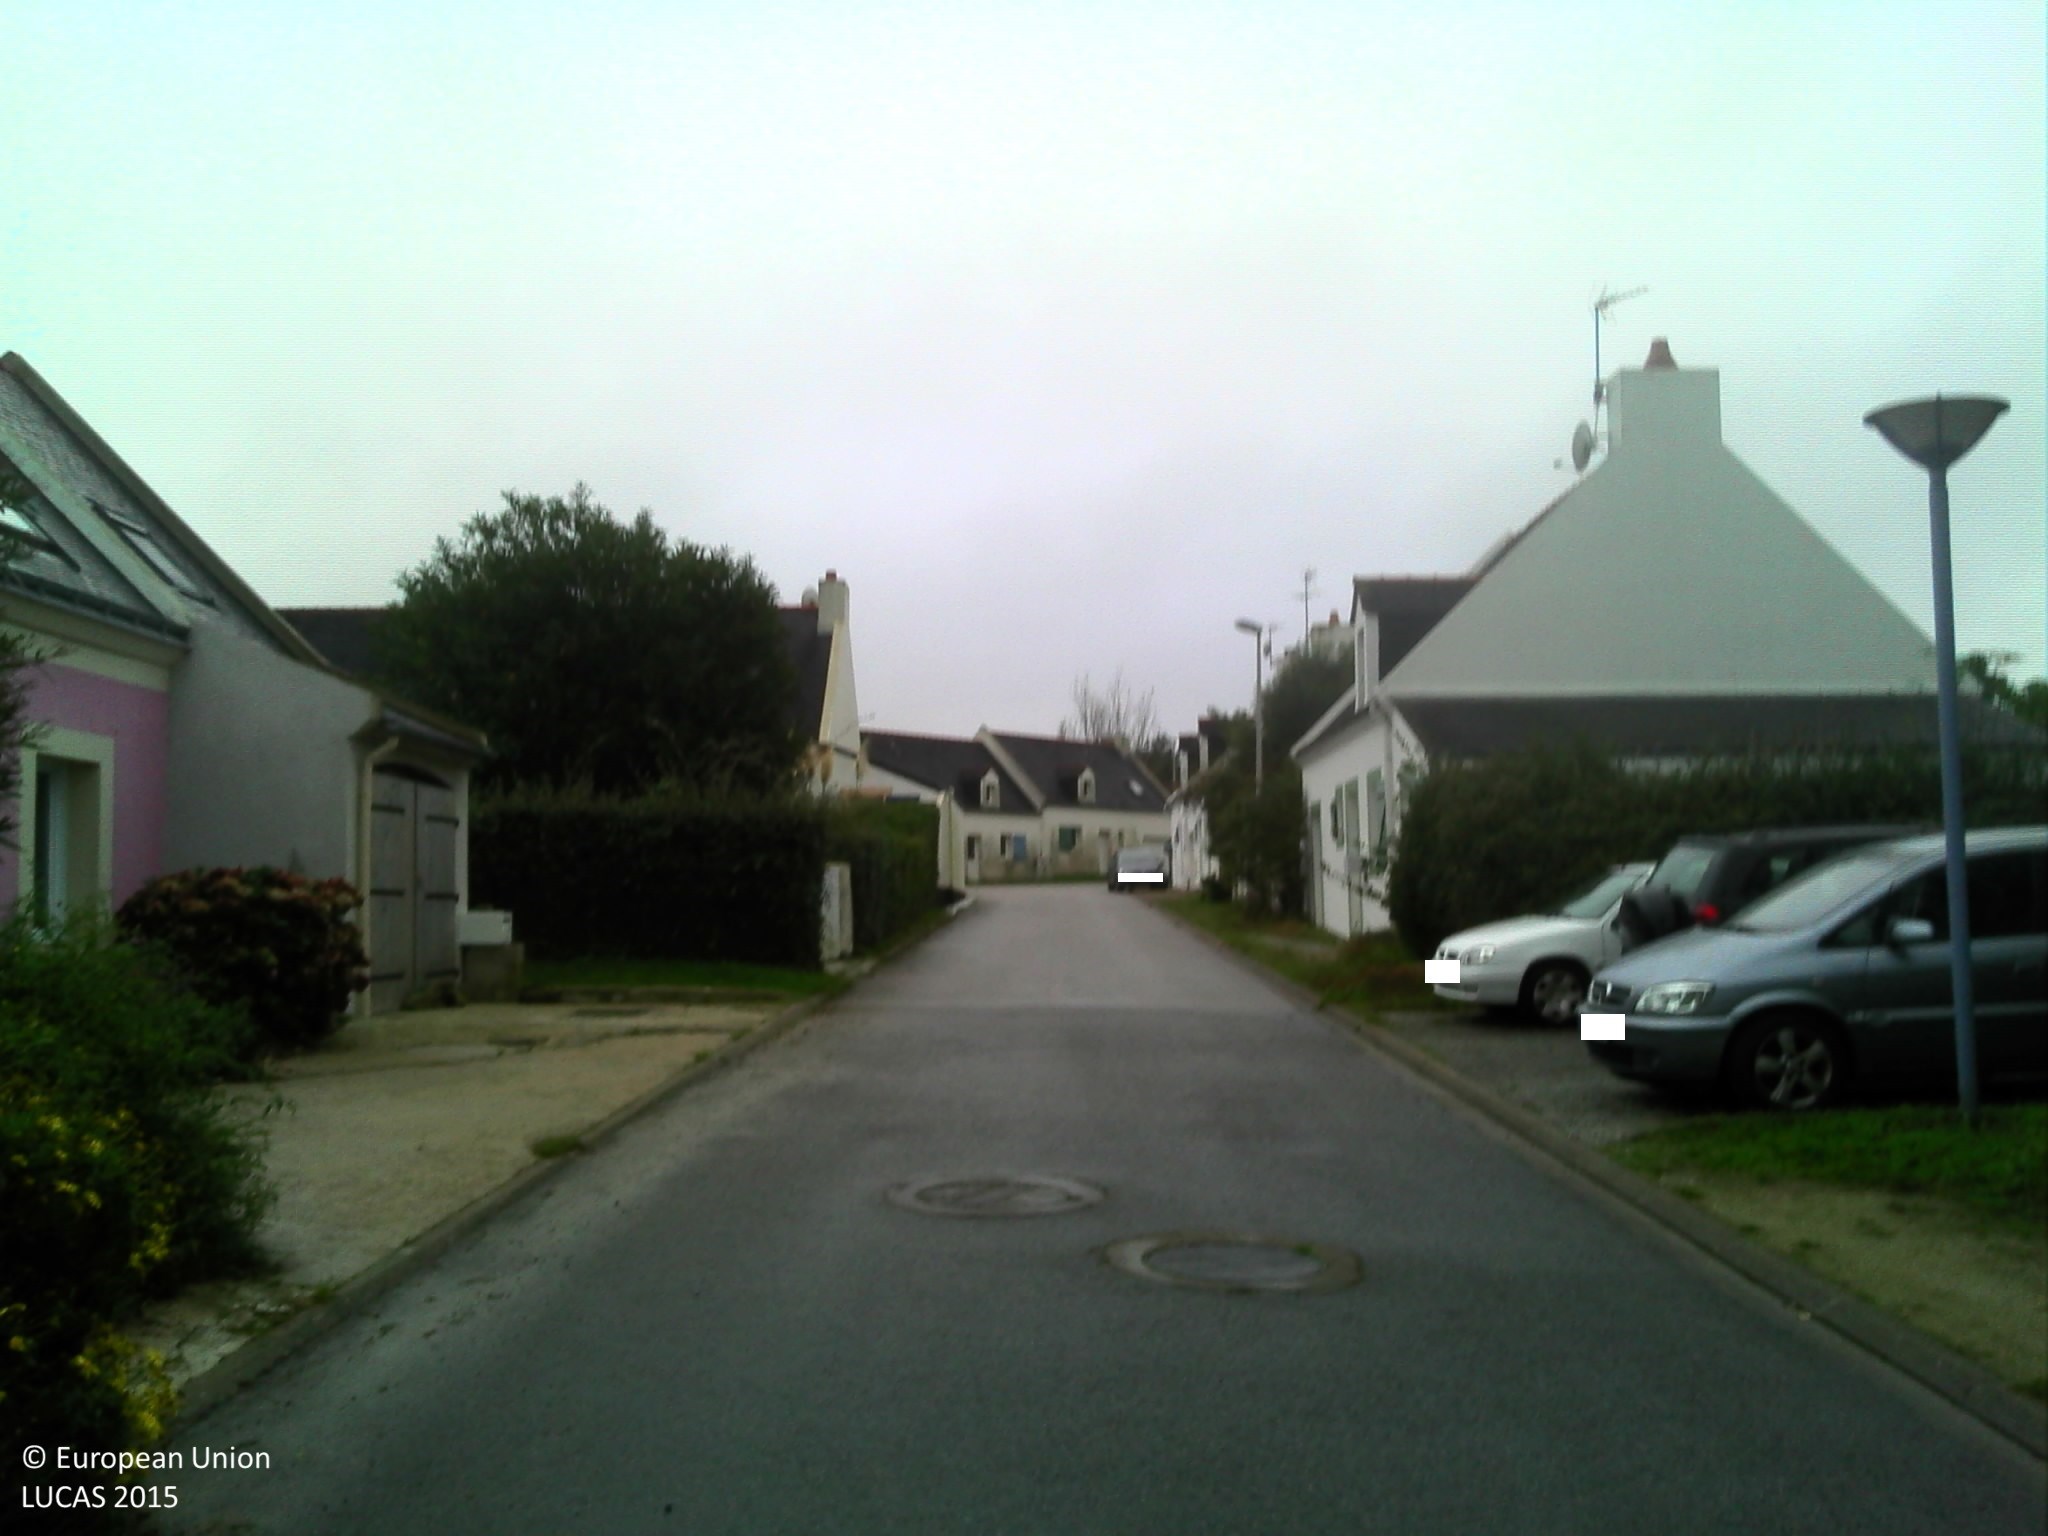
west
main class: Grassland
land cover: Grassland without tree/shrub cover
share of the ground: > 75 %
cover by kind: herbaceous plants 100 %
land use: Residential
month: November
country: FR
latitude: 47.3397
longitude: -3.1563
